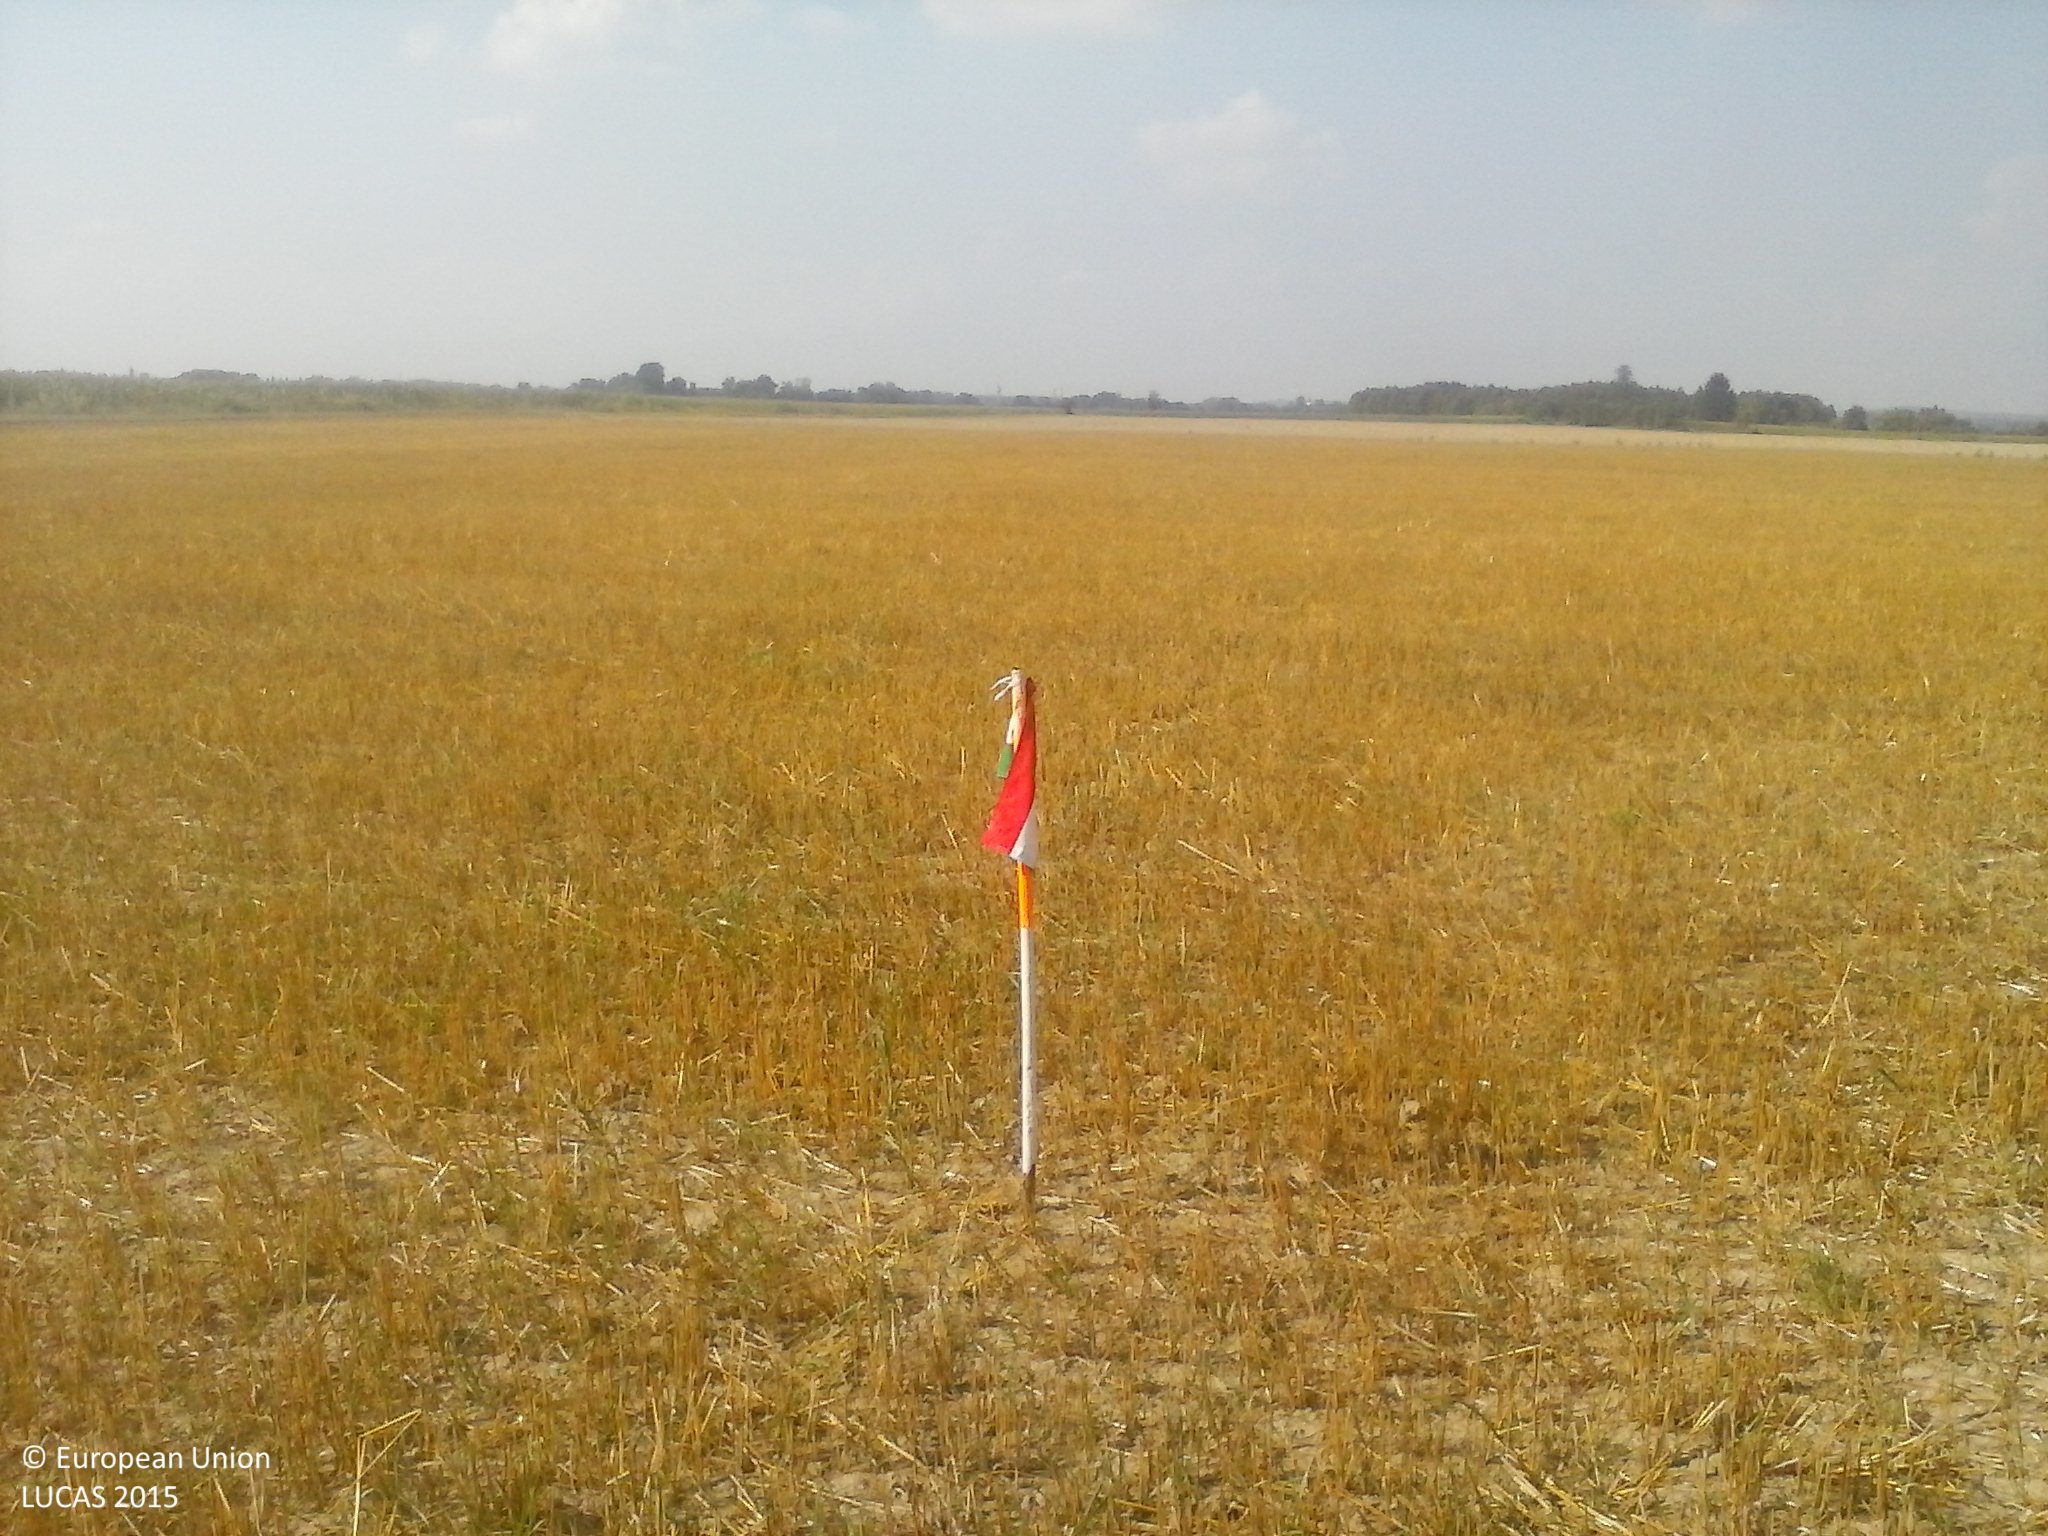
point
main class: Cropland
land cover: Oats
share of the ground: > 75 %
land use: Agriculture (excluding fallow land and kitchen gardens)
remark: Harvested field
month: August
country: HU
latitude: 46.0124
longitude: 17.7926
